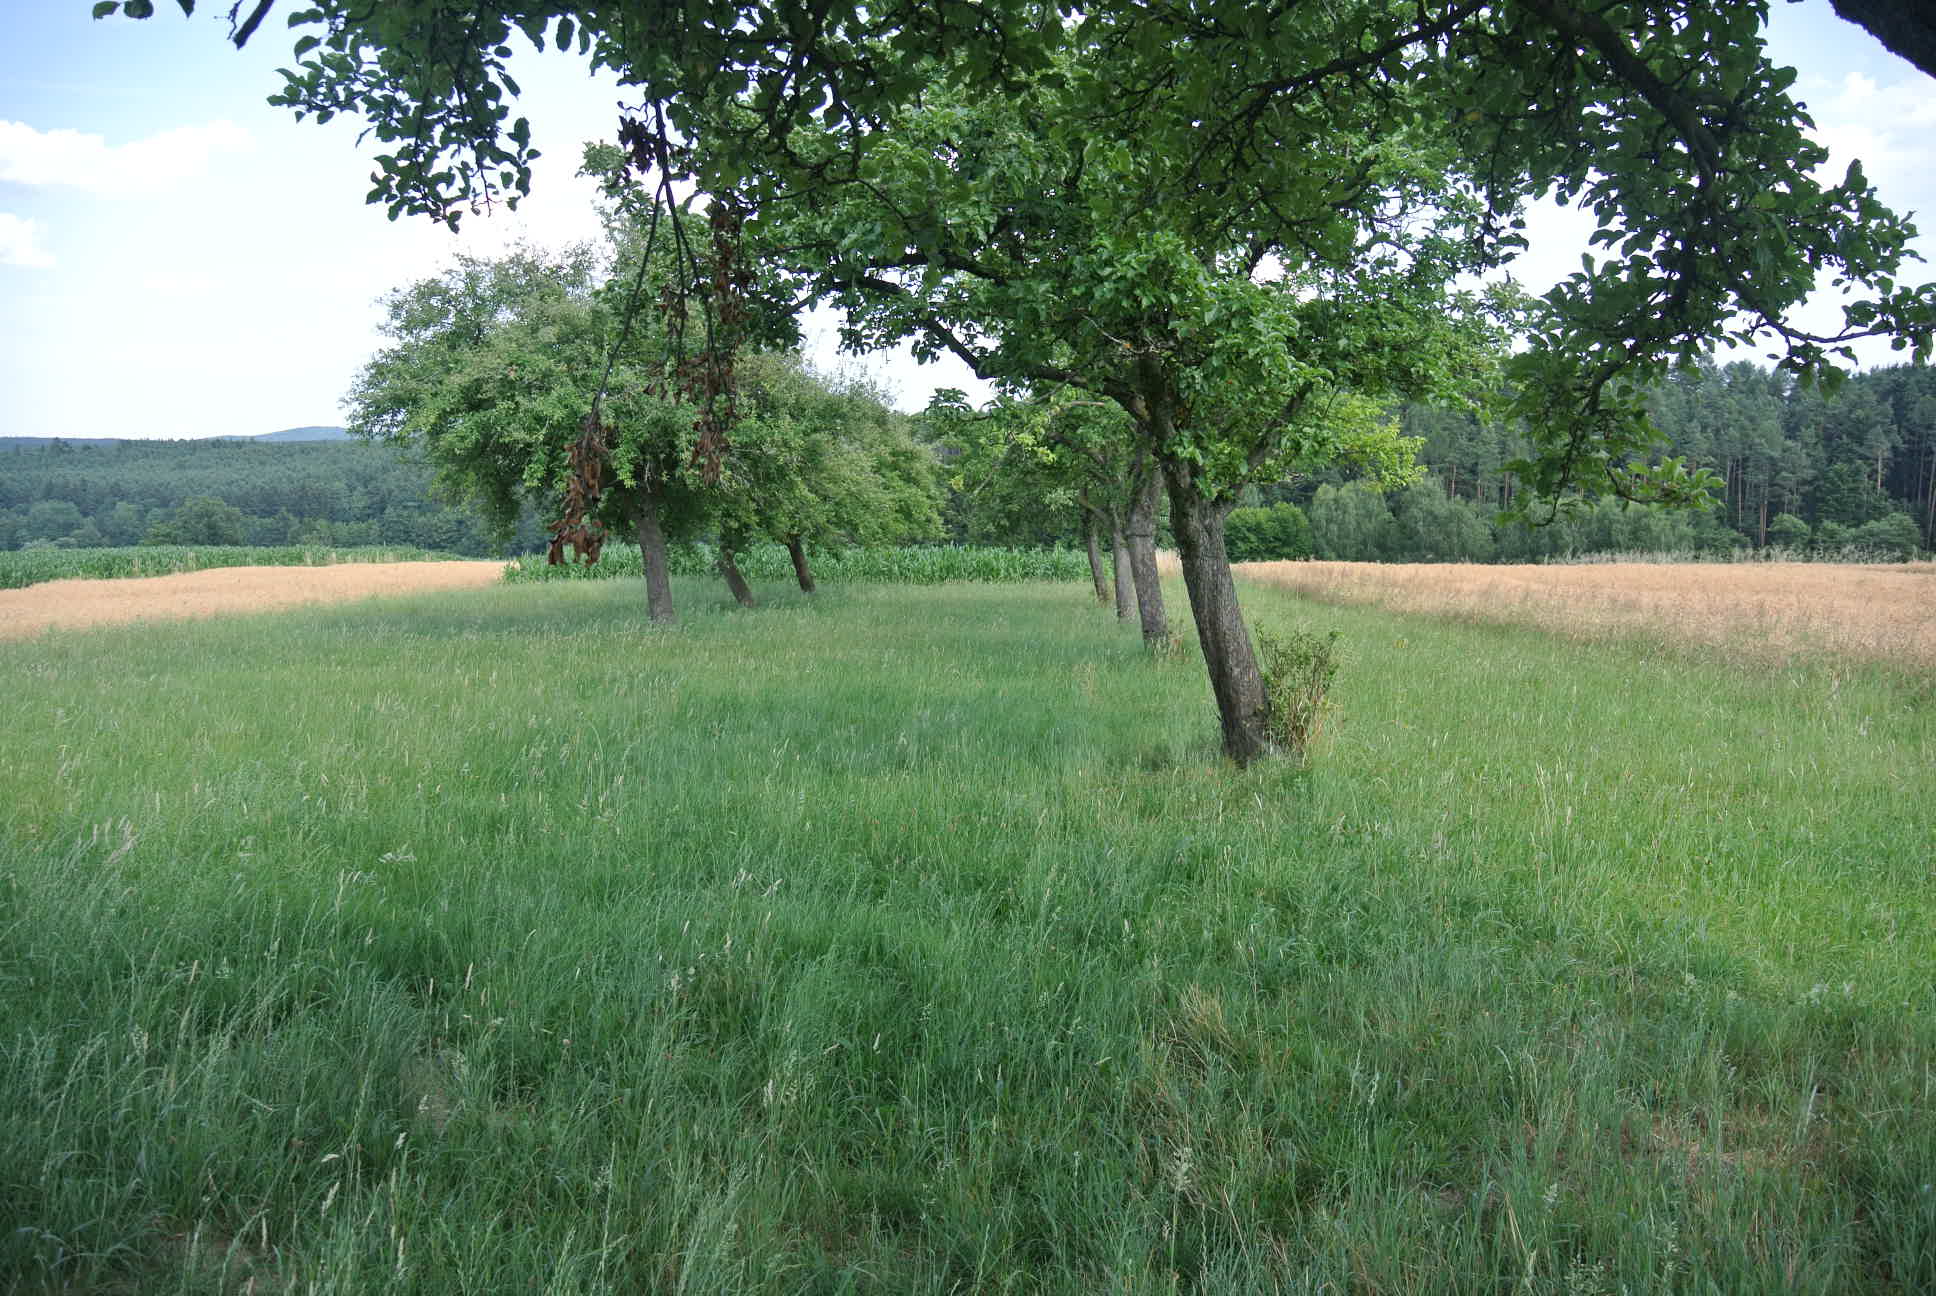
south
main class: Cropland
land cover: Apple fruit
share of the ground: > 75 %
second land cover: Spontaneously vegetated surfaces
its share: > 75 %
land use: Kitchen garden
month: July
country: AT
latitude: 47.6777
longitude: 16.0634
